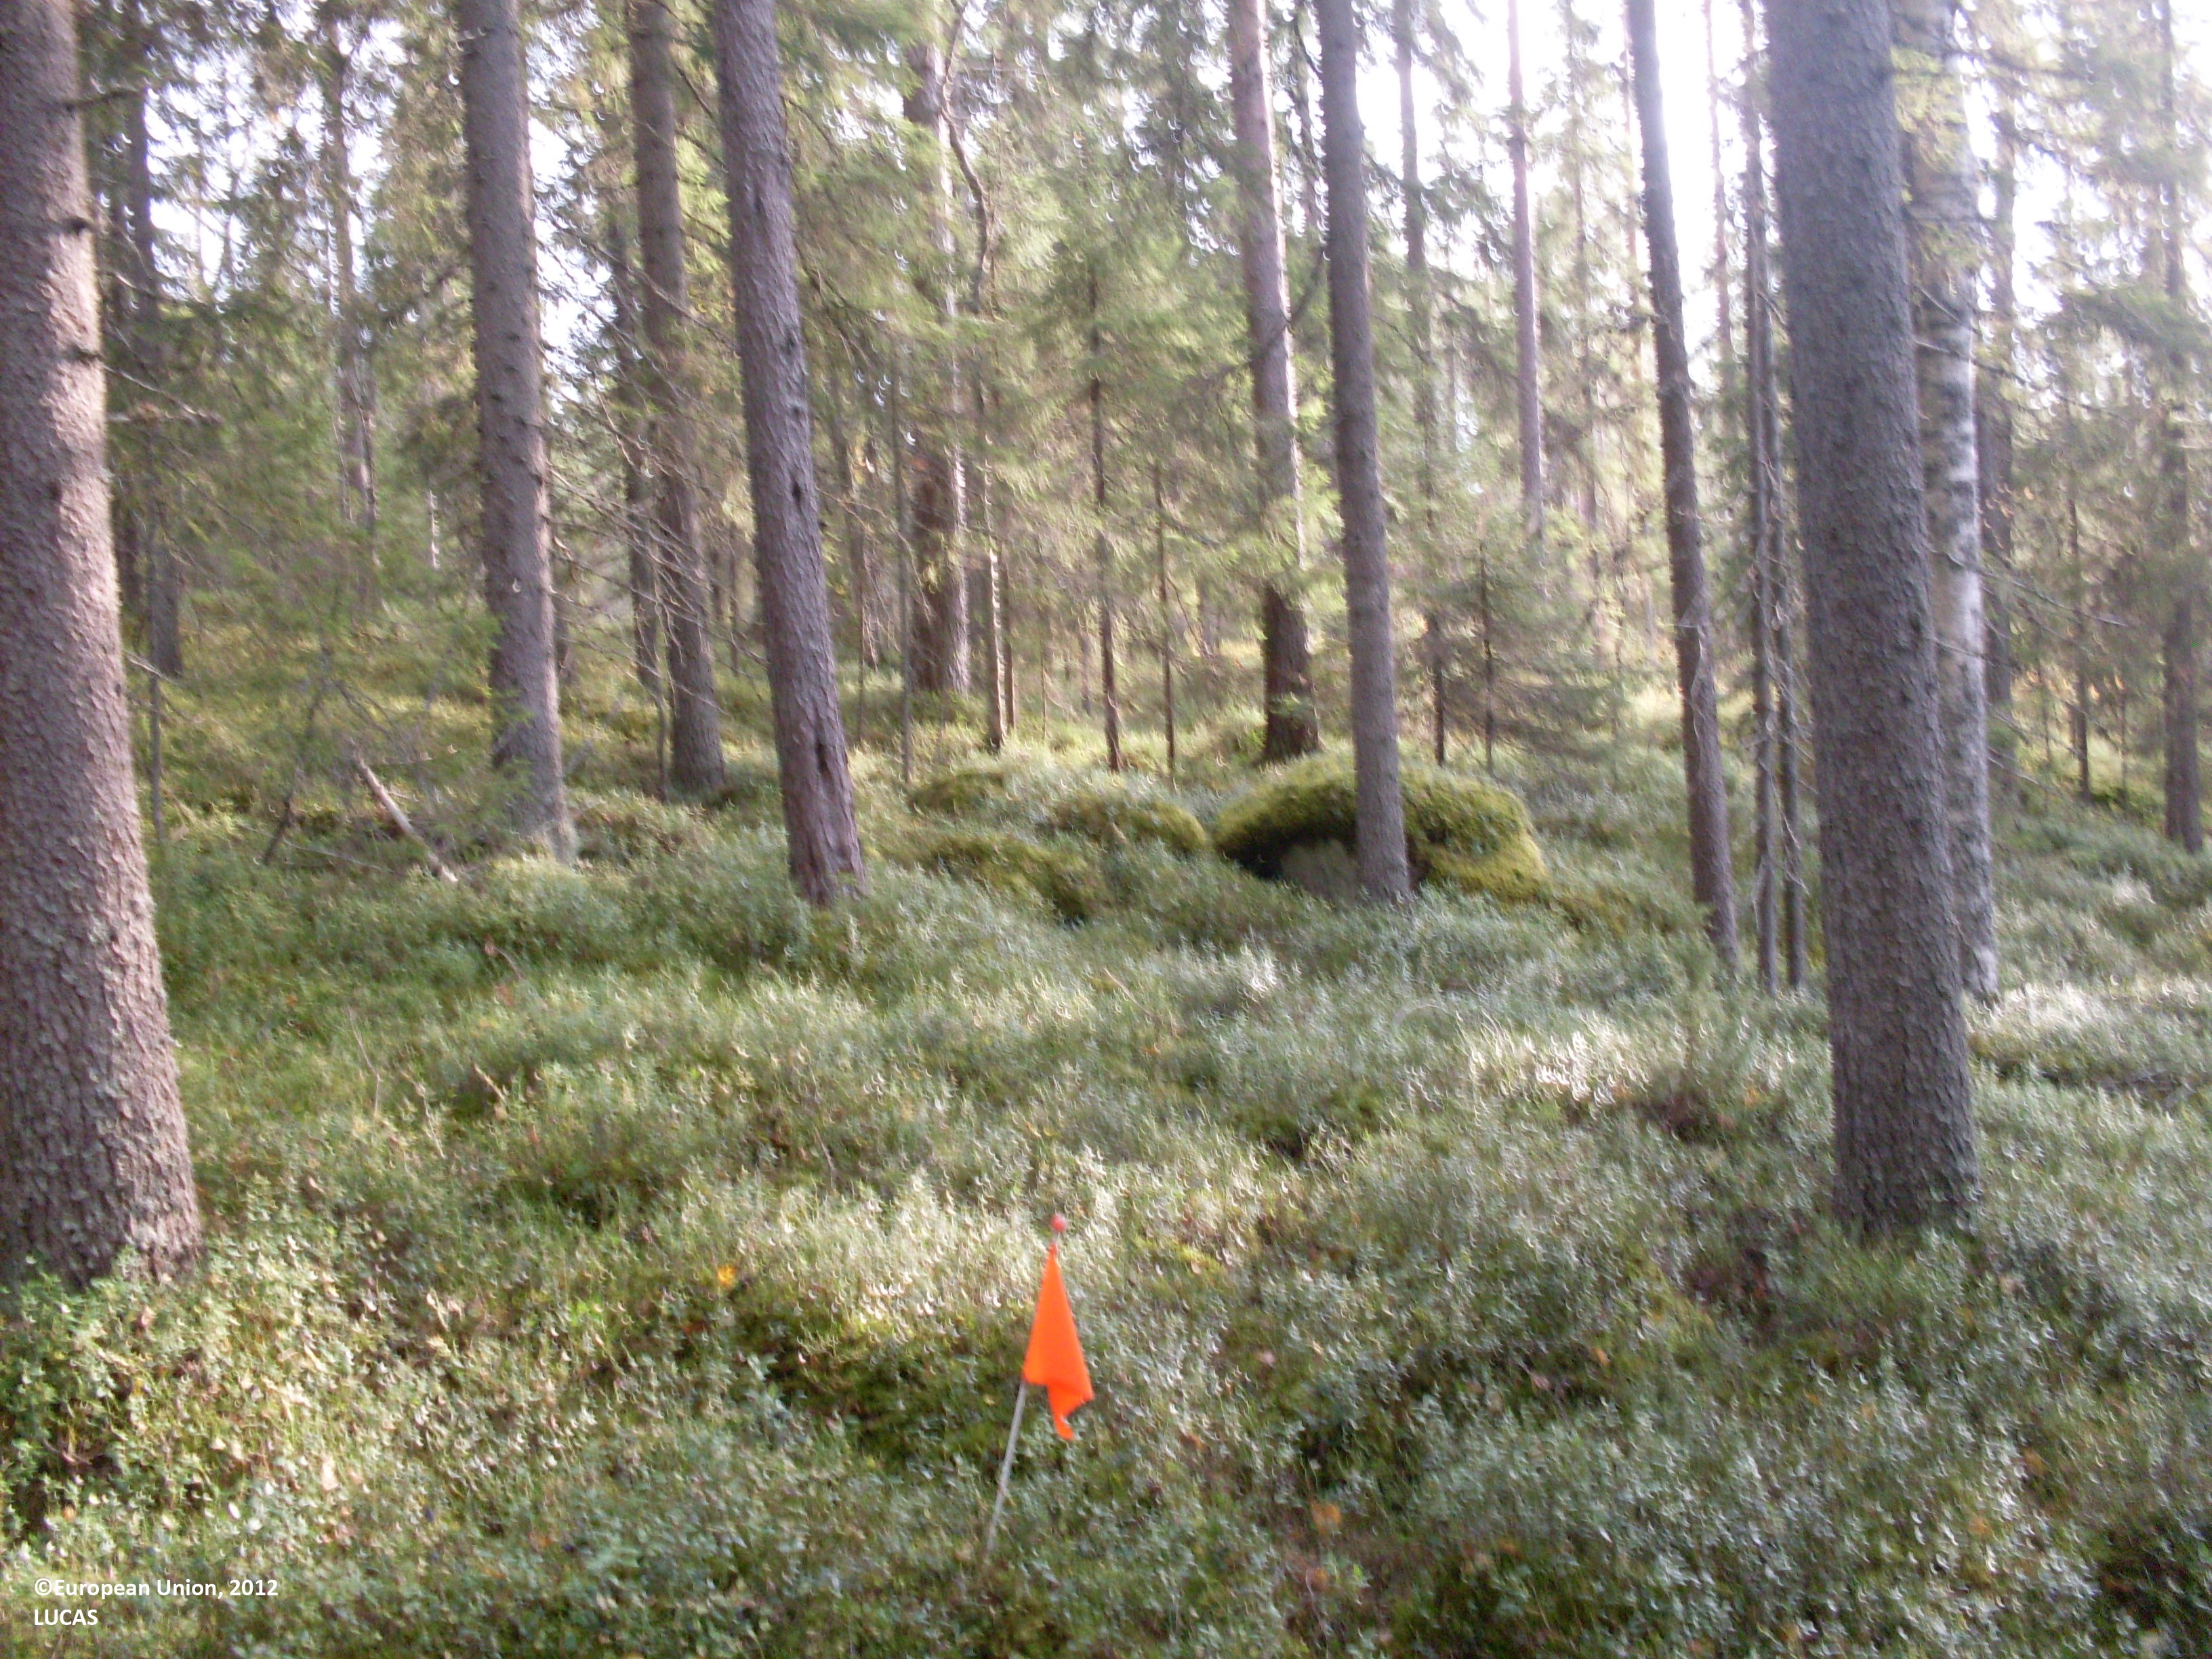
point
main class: Woodland
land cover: Spruce dominated mixed woodland
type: boreal forest
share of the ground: > 75 %
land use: Forestry
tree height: > 5 m
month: September
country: FI
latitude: 64.3924
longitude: 28.5309
